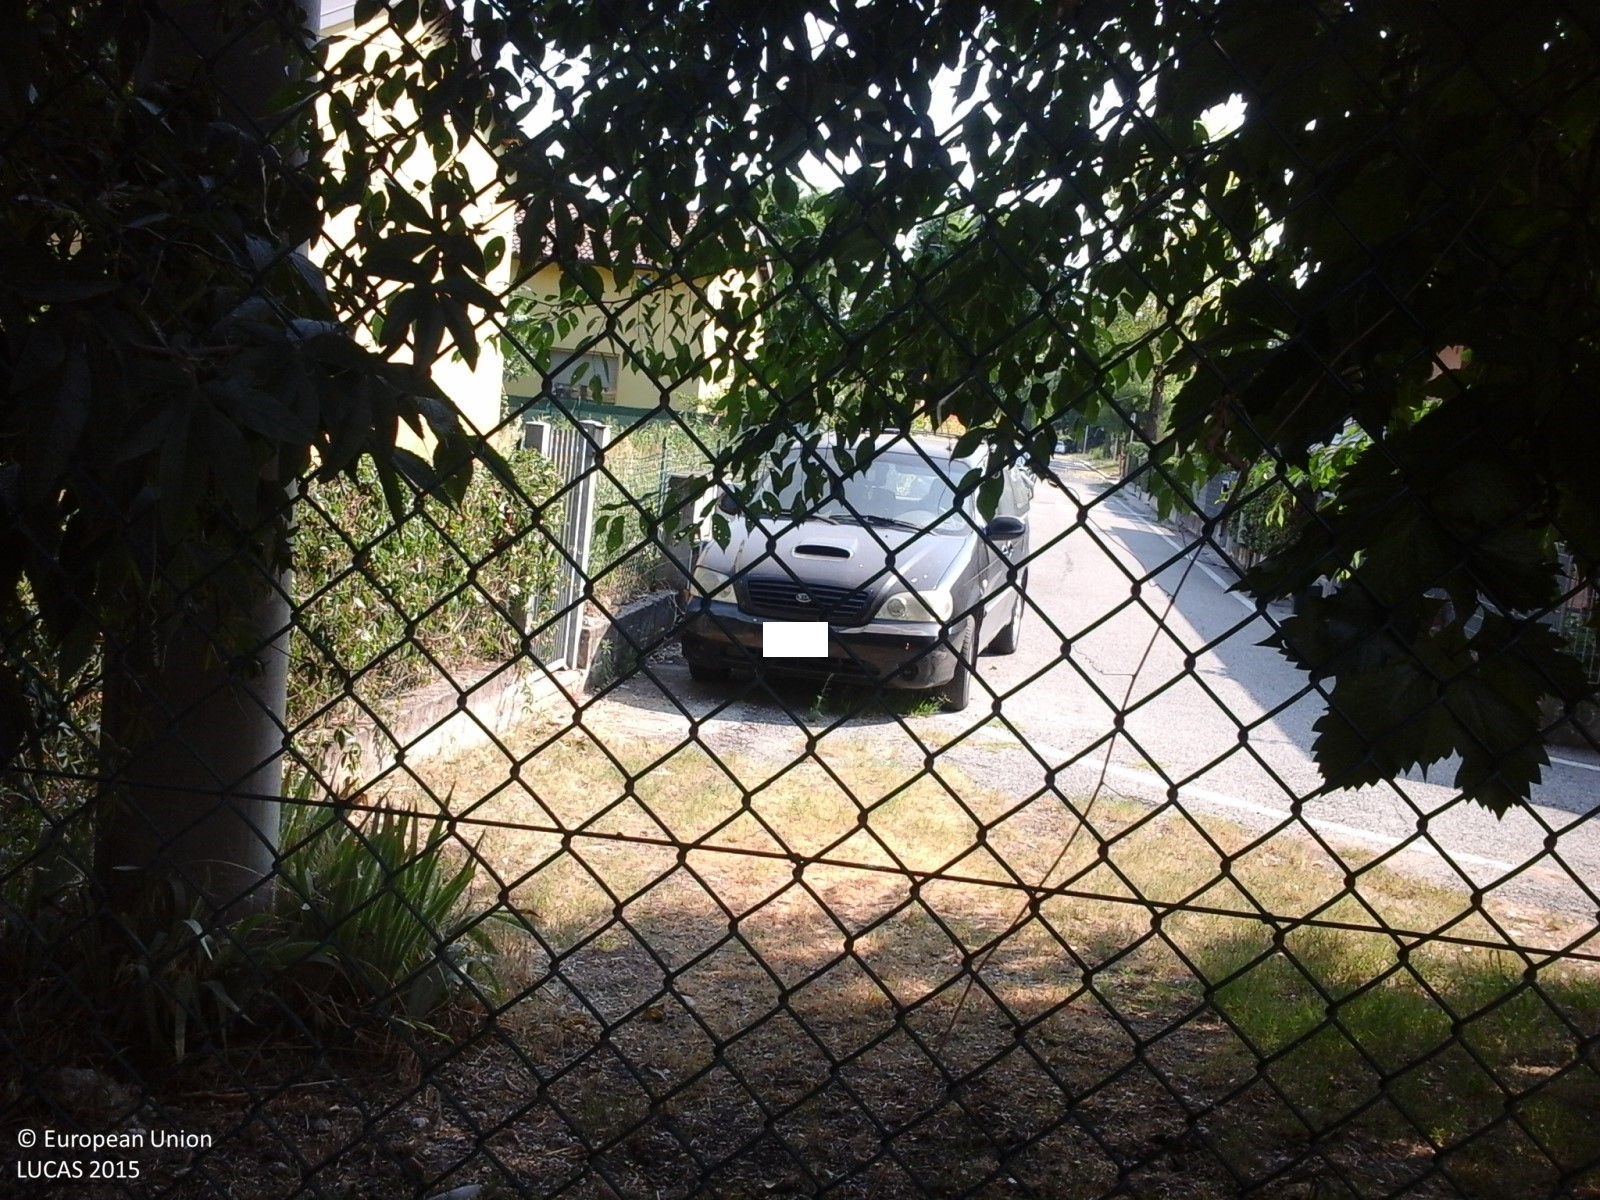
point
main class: Grassland
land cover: Grassland without tree/shrub cover
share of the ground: > 75 %
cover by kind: herbaceous plants 100 %
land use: Residential
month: July
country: IT
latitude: 45.3568
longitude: 10.8538
